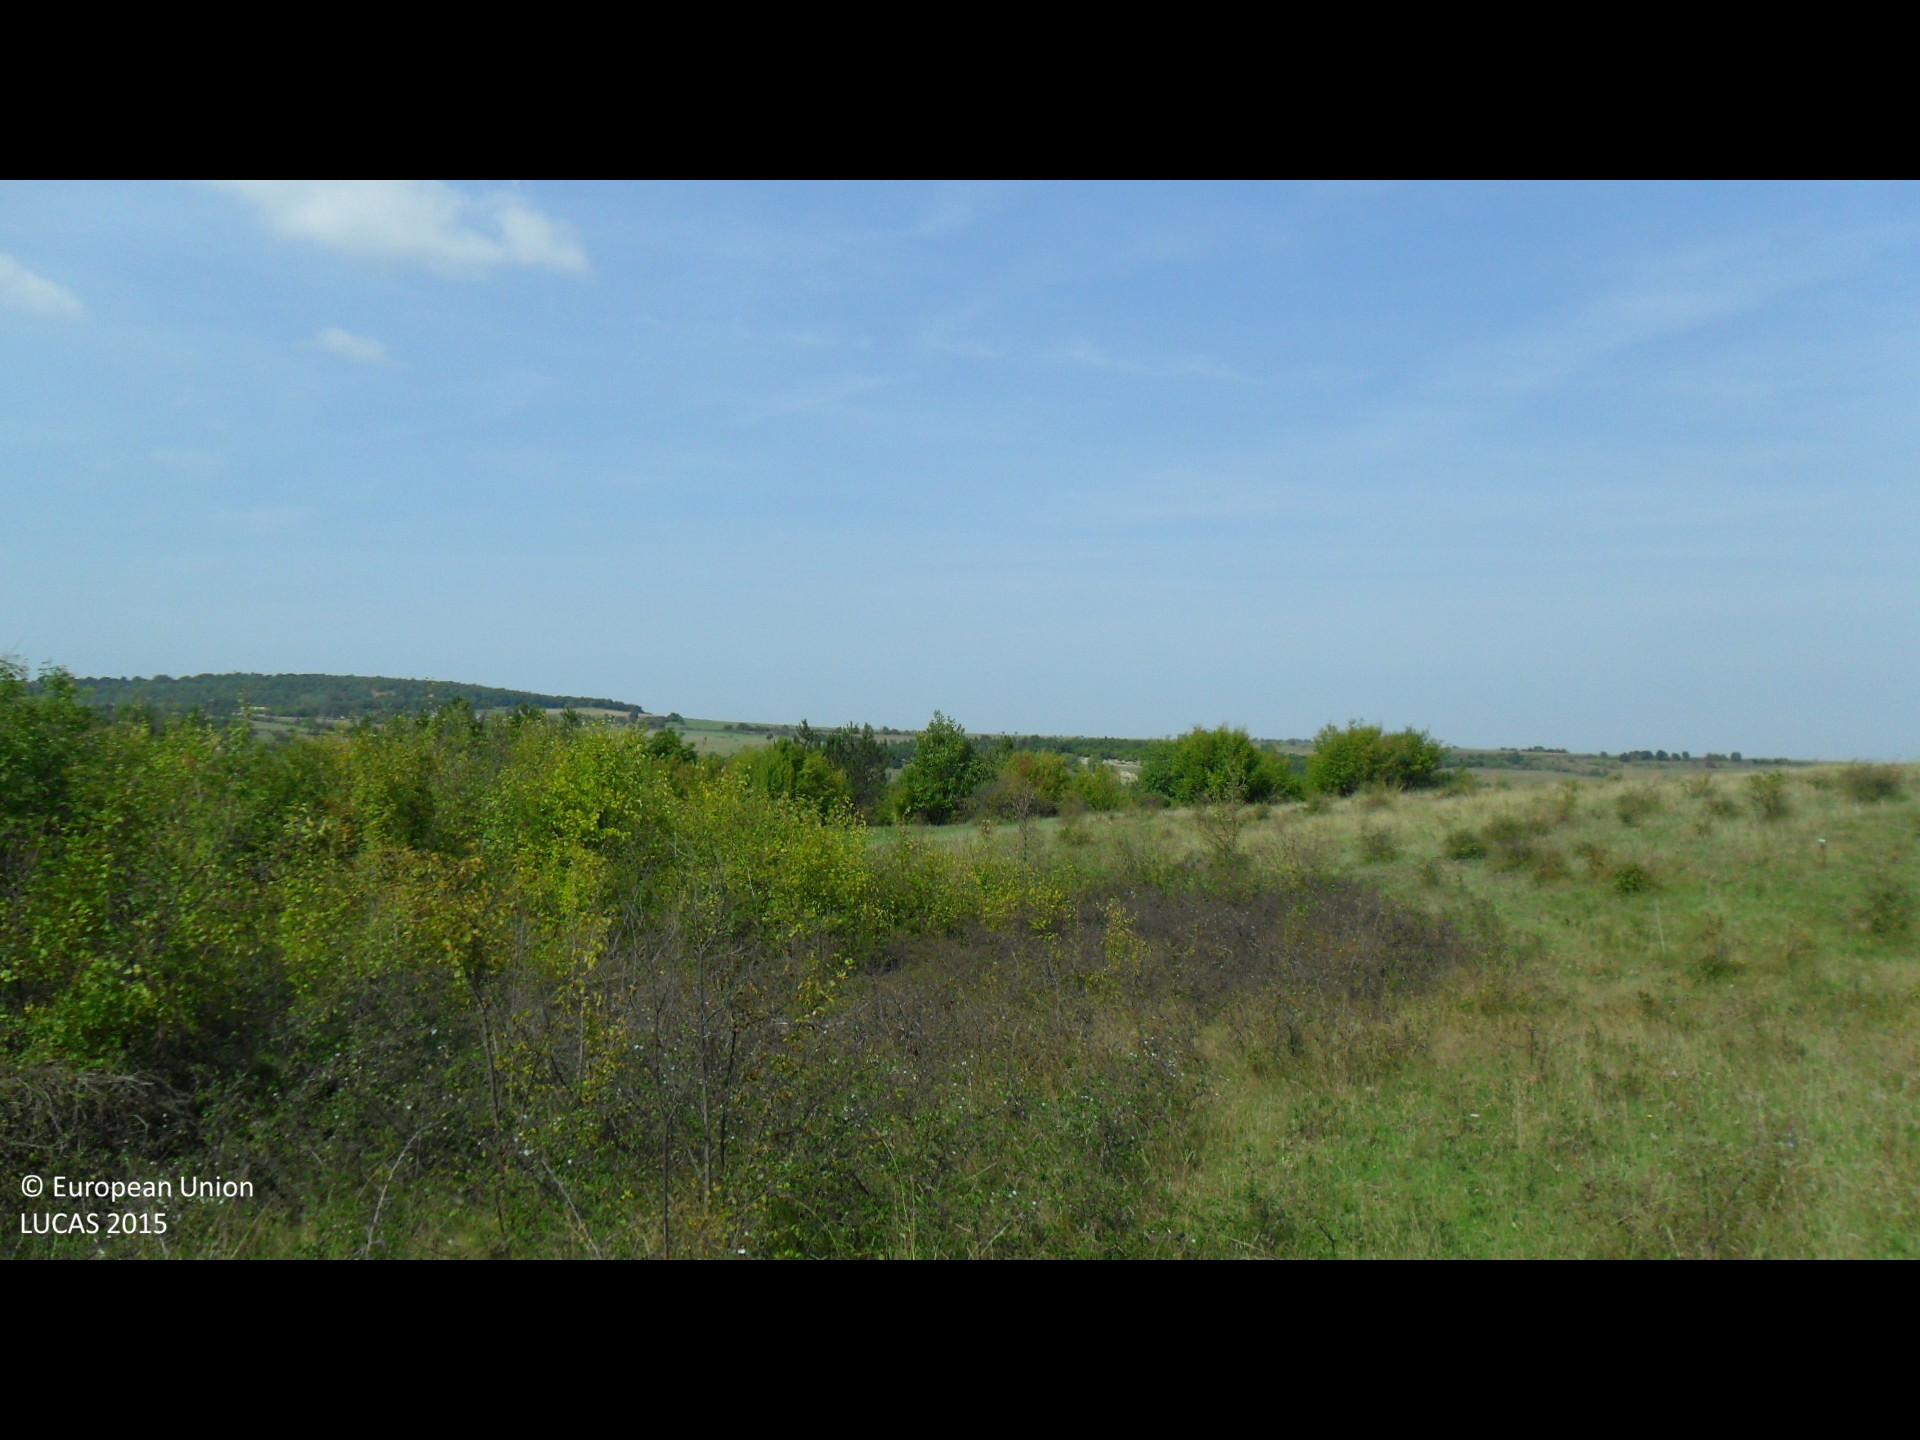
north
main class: Grassland
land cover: Grassland without tree/shrub cover
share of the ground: > 75 %
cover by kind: herbaceous plants 100 %
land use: Agriculture (excluding fallow land and kitchen gardens)
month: September
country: BG
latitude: 43.0179
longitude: 26.5043
